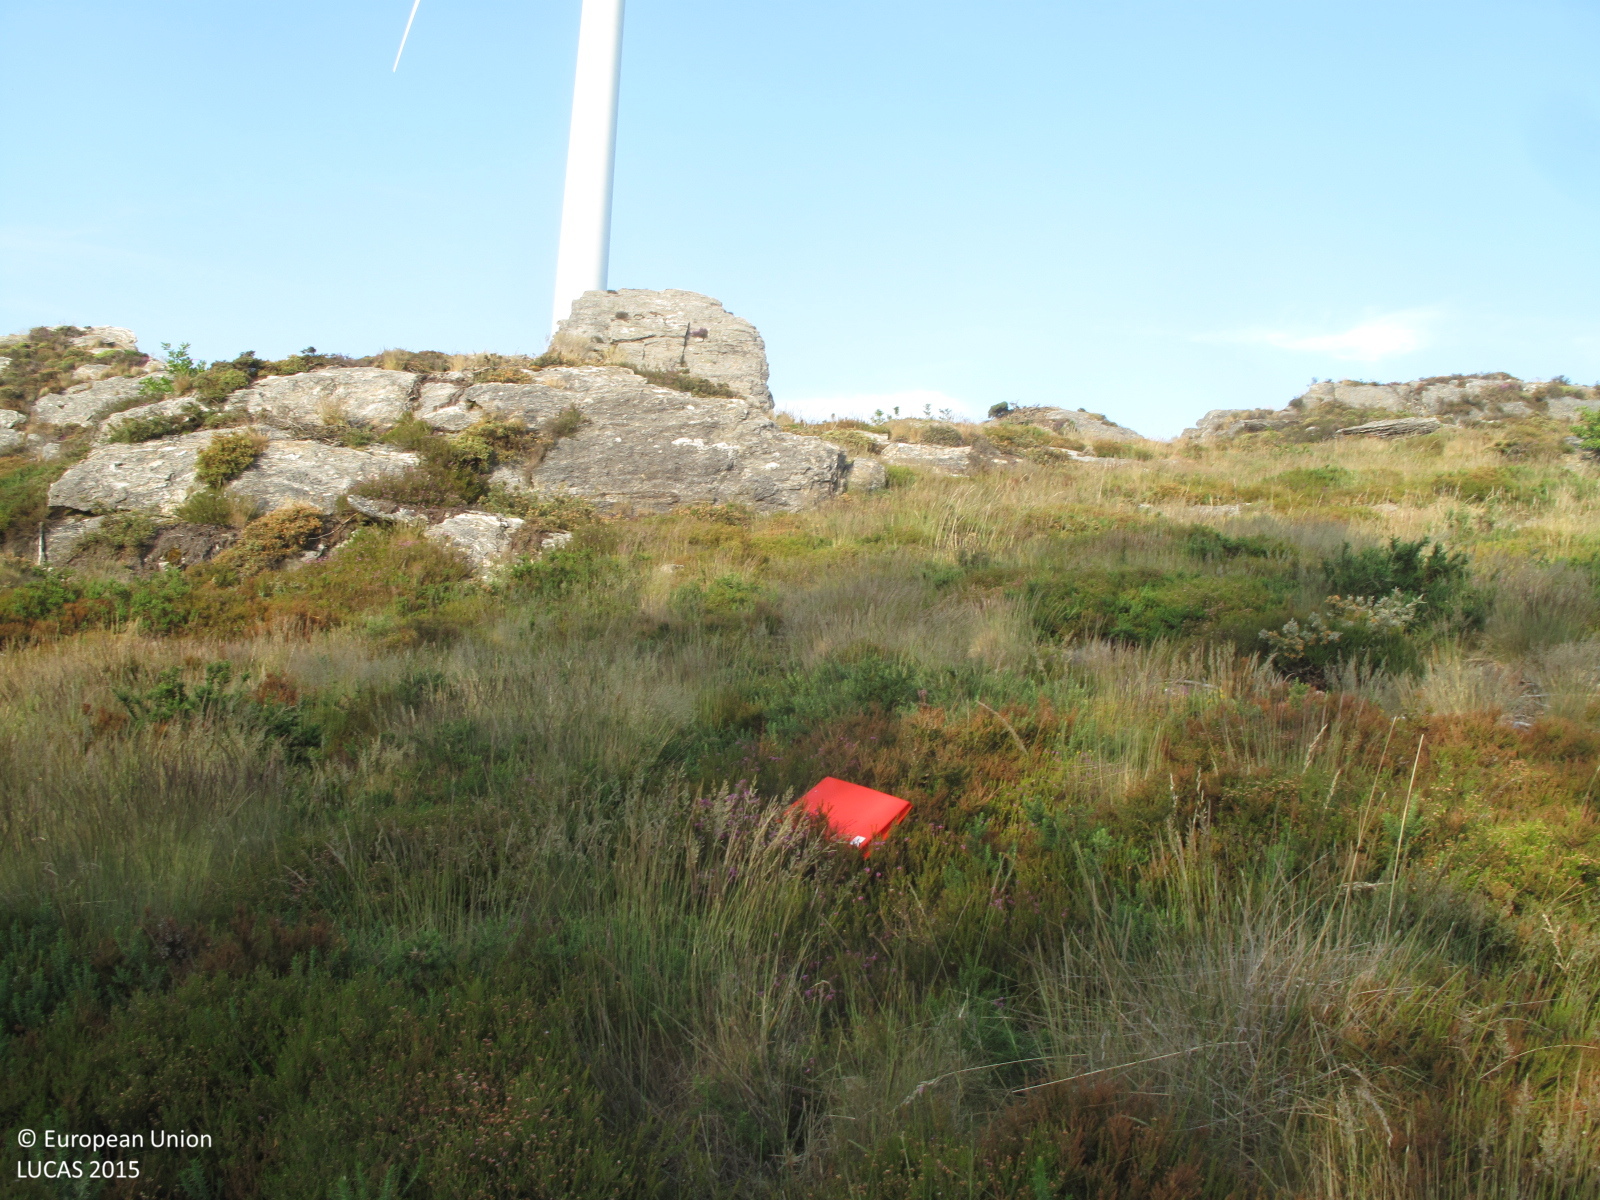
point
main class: Shrubland
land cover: Shrubland with sparse tree cover
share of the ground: 25 - 50 %
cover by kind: herbaceous plants 50 %, shrubs 45 %, broadleaved forest trees 5 %
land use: Semi-natural and natural areas not in use
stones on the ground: 10 - 25 %
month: June
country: ES
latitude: 43.0896
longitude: -7.9134
